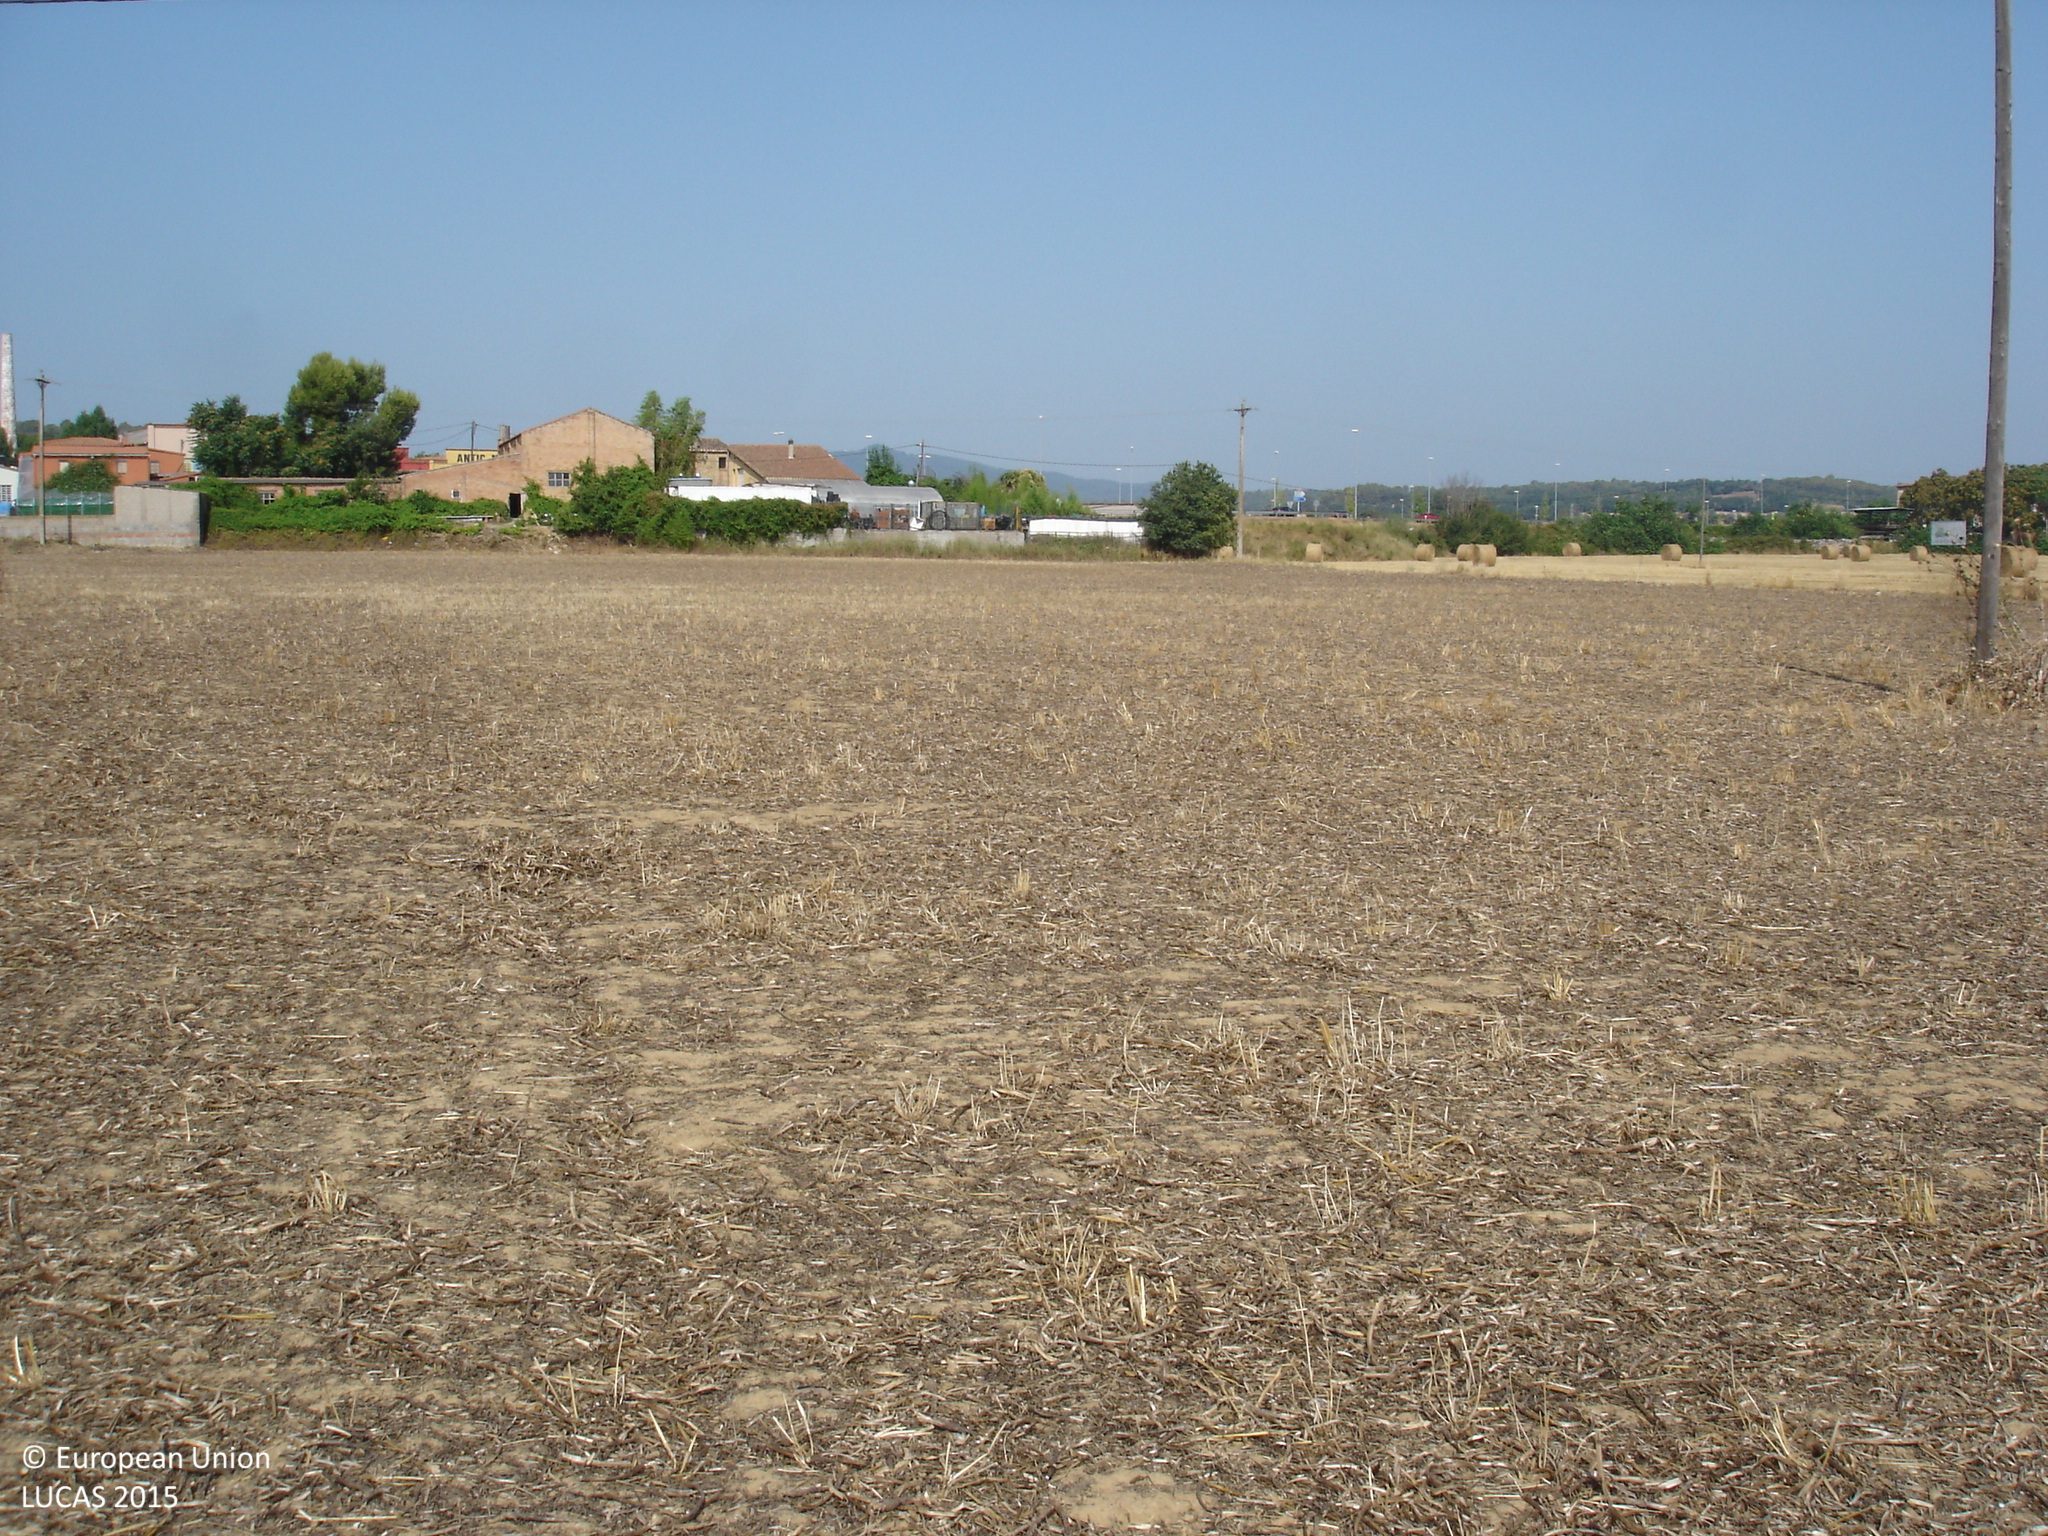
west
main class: Cropland
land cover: Rape and turnip rape
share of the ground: < 10 %
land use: Agriculture (excluding fallow land and kitchen gardens)
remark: Harvested field
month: July
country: ES
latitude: 41.9786
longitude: 3.0280
